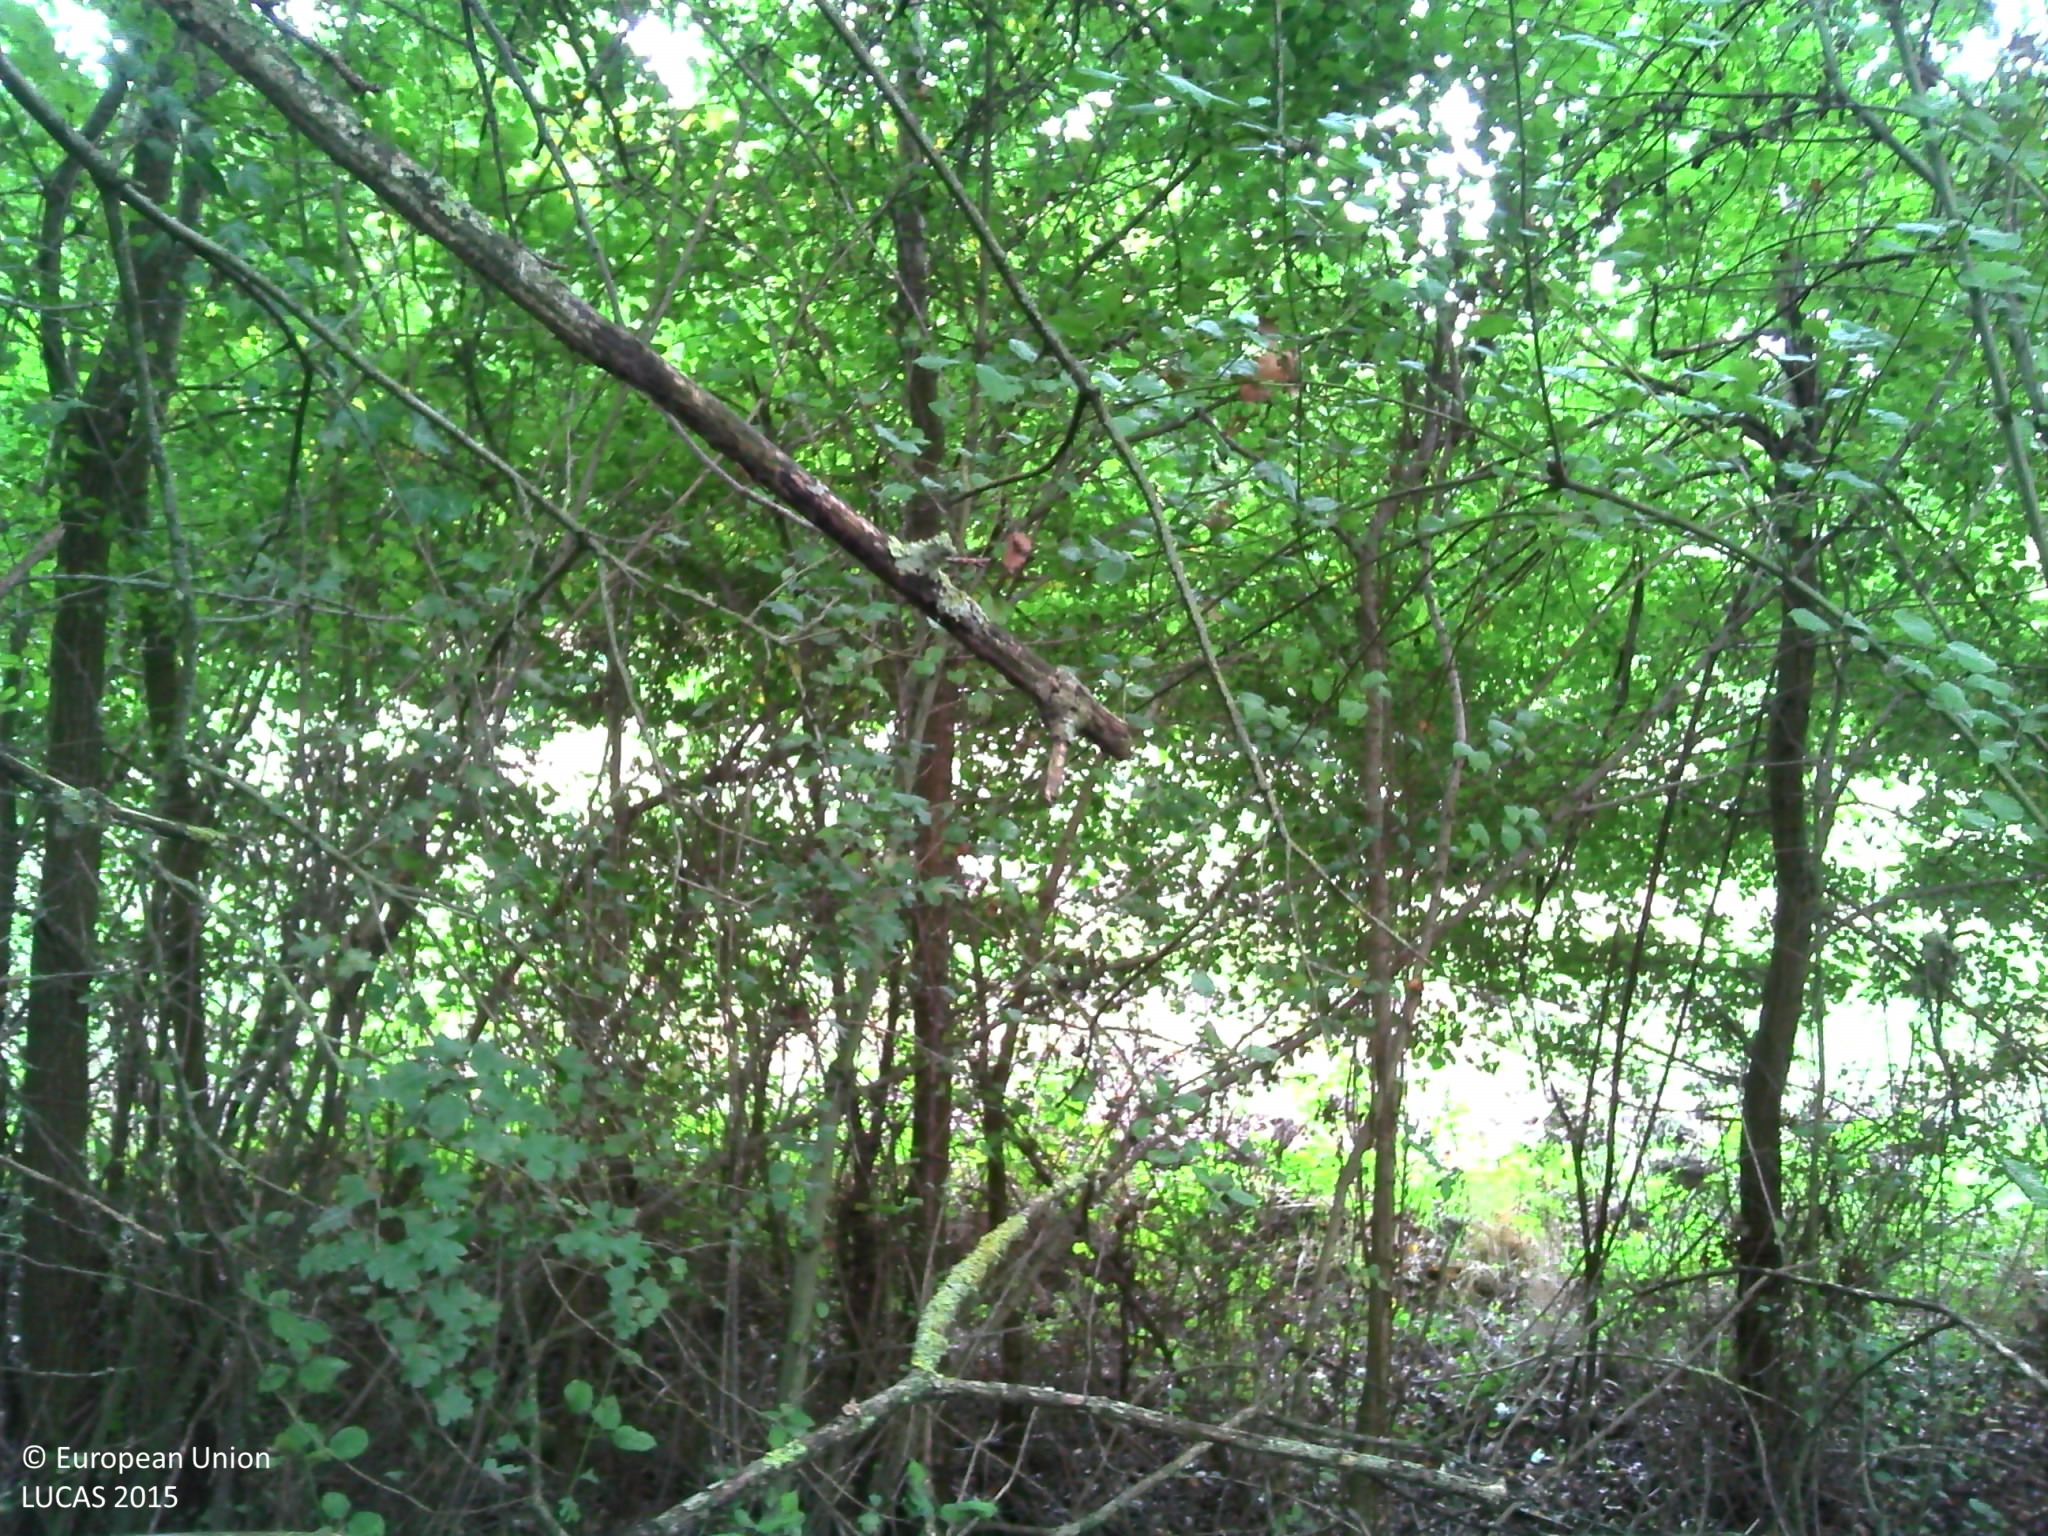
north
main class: Woodland
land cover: Broadleaved woodland
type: mesophytic deciduous forest
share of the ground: > 75 %
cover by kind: broadleaved forest trees 100 %
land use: Forestry
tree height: > 5 m
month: August
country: FR
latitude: 47.1314
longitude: 2.1736
